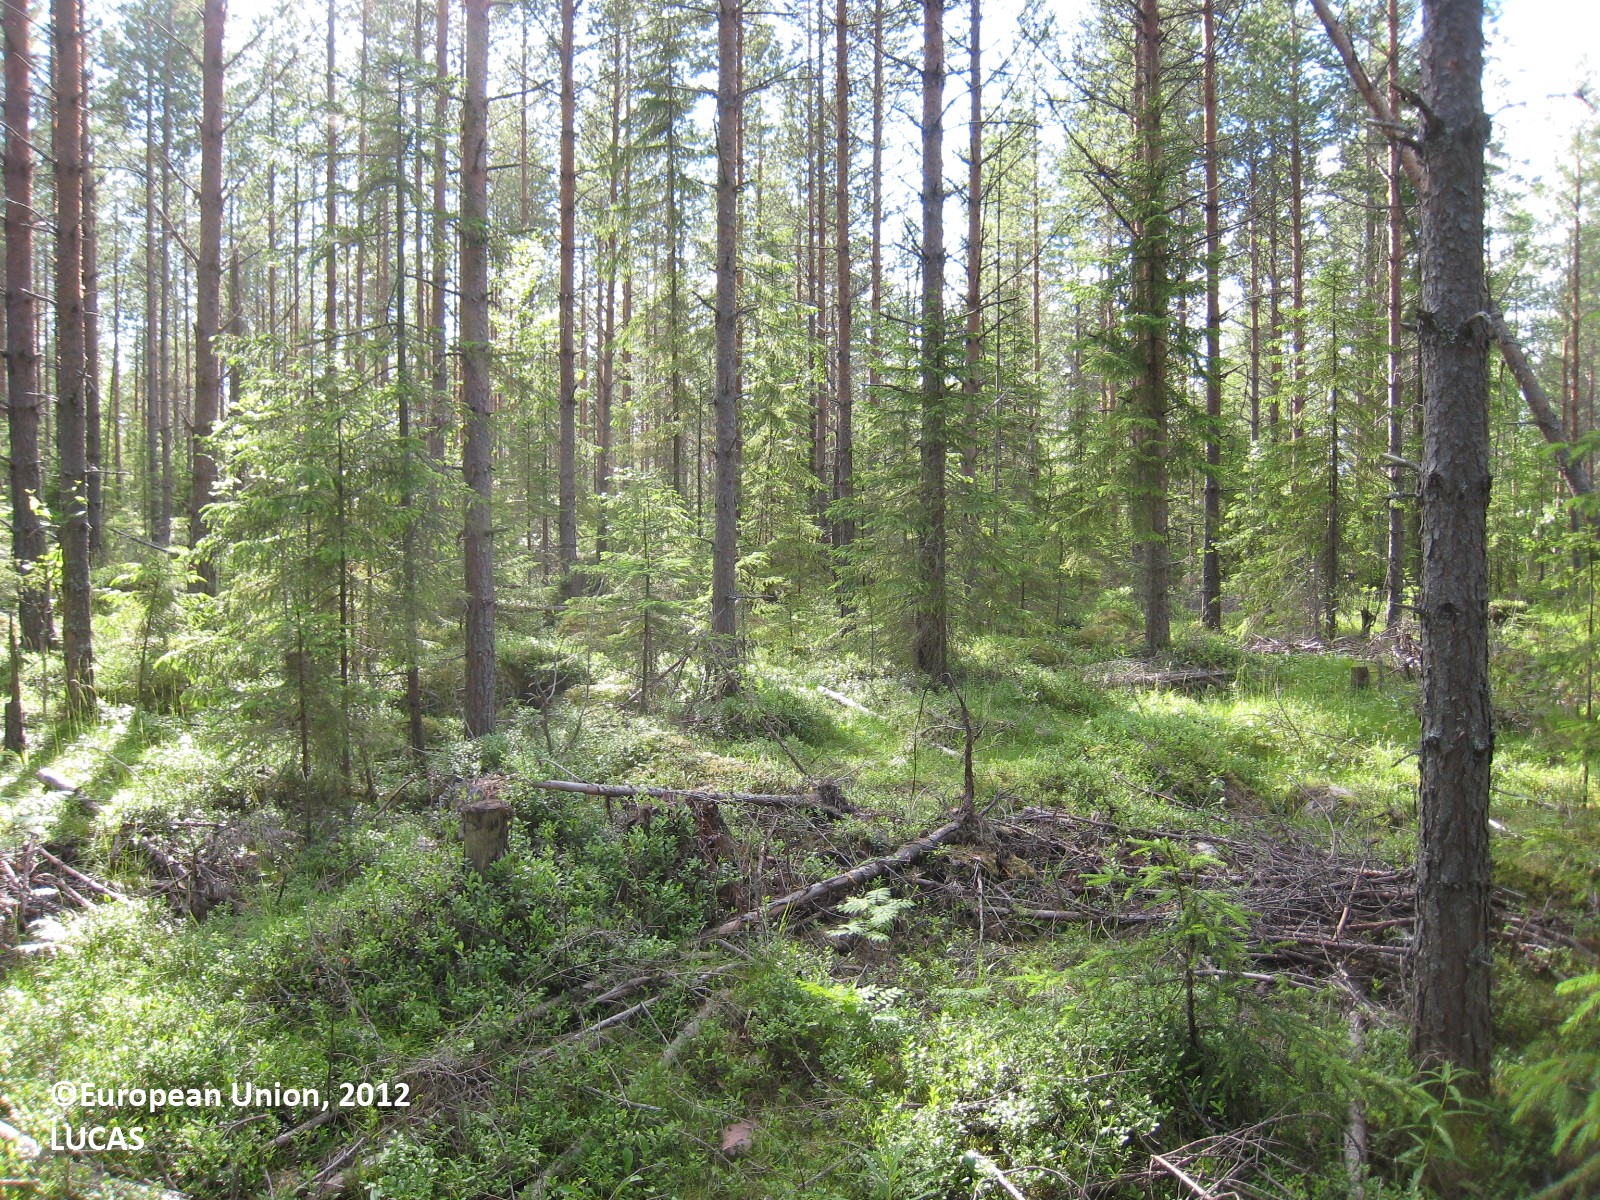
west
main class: Woodland
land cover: Other coniferous woodland
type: boreal forest
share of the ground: 50 - 75 %
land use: Forestry
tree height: > 5 m
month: July
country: FI
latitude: 62.7786
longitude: 25.6920
